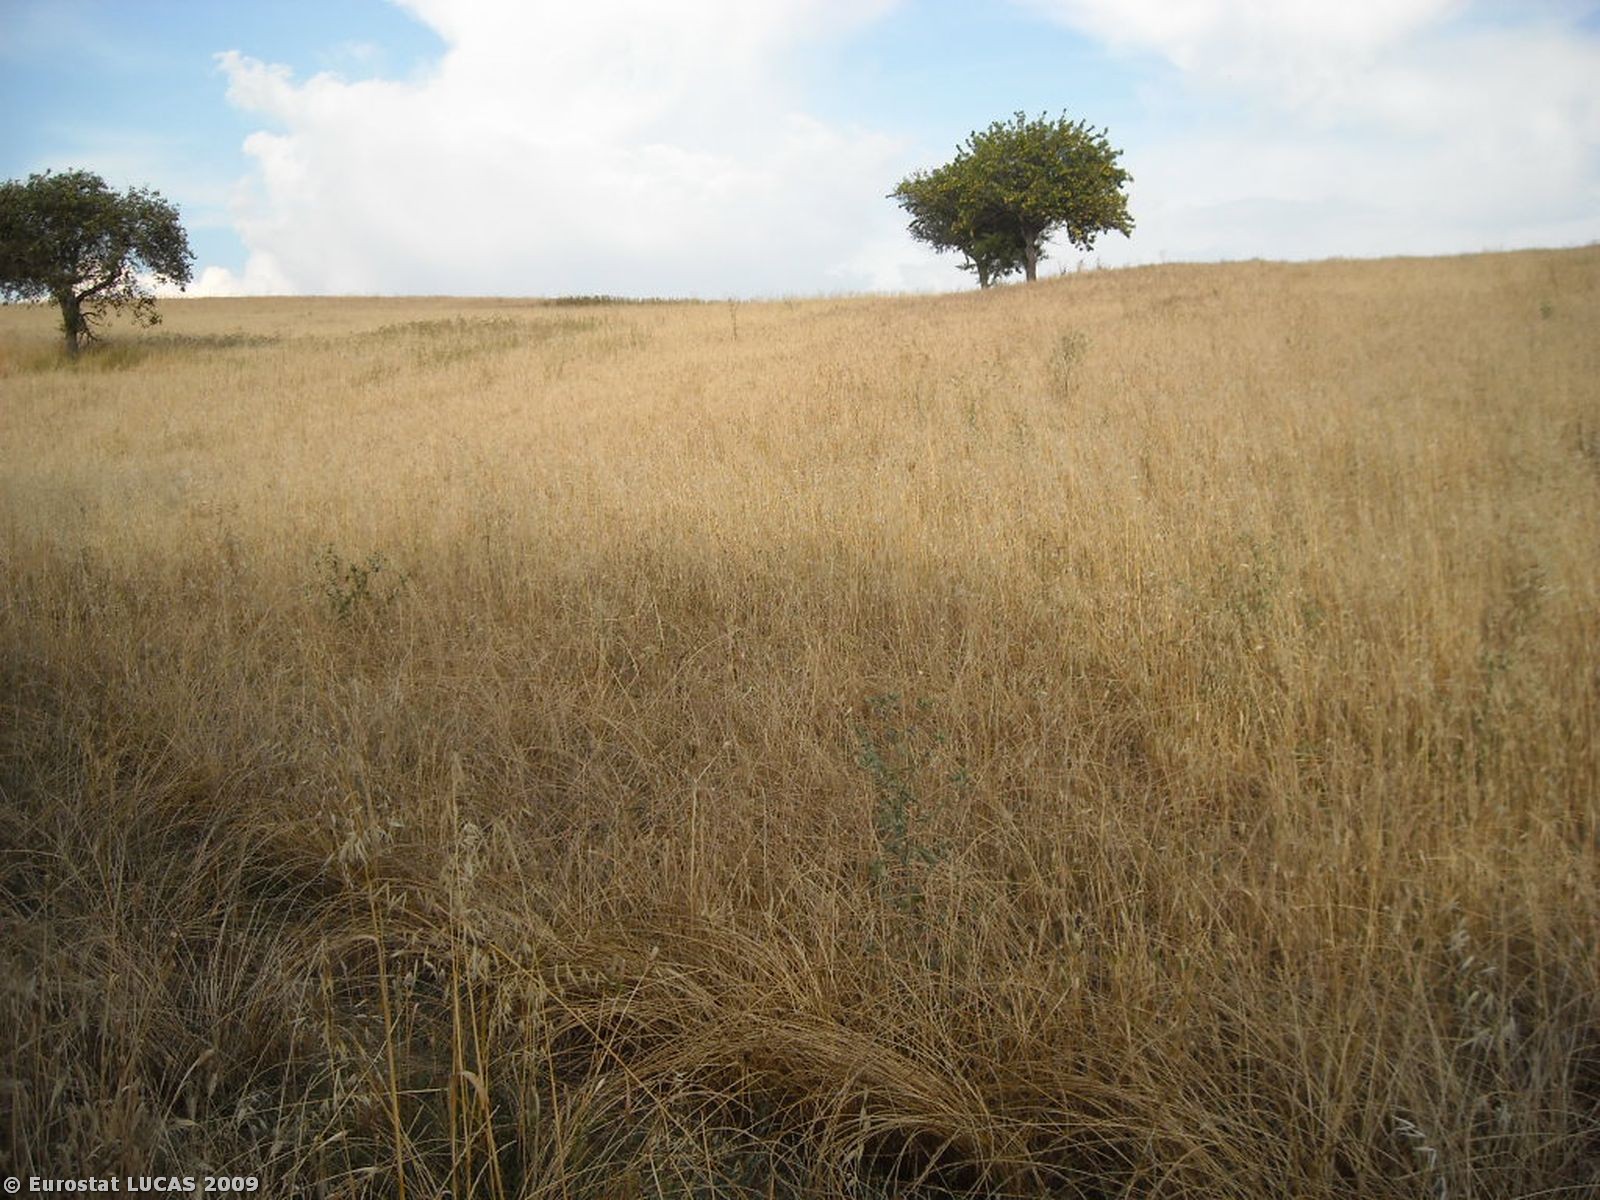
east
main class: Woodland
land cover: Broadleaved woodland
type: thermophilous deciduous forest
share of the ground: > 75 %
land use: Agriculture (excluding fallow land and kitchen gardens)
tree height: > 5 m
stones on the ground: < 10 %
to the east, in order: Broadleaved woodland; Durum wheat; Barley; Durum wheat
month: July
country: IT
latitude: 40.6555
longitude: 16.1392
